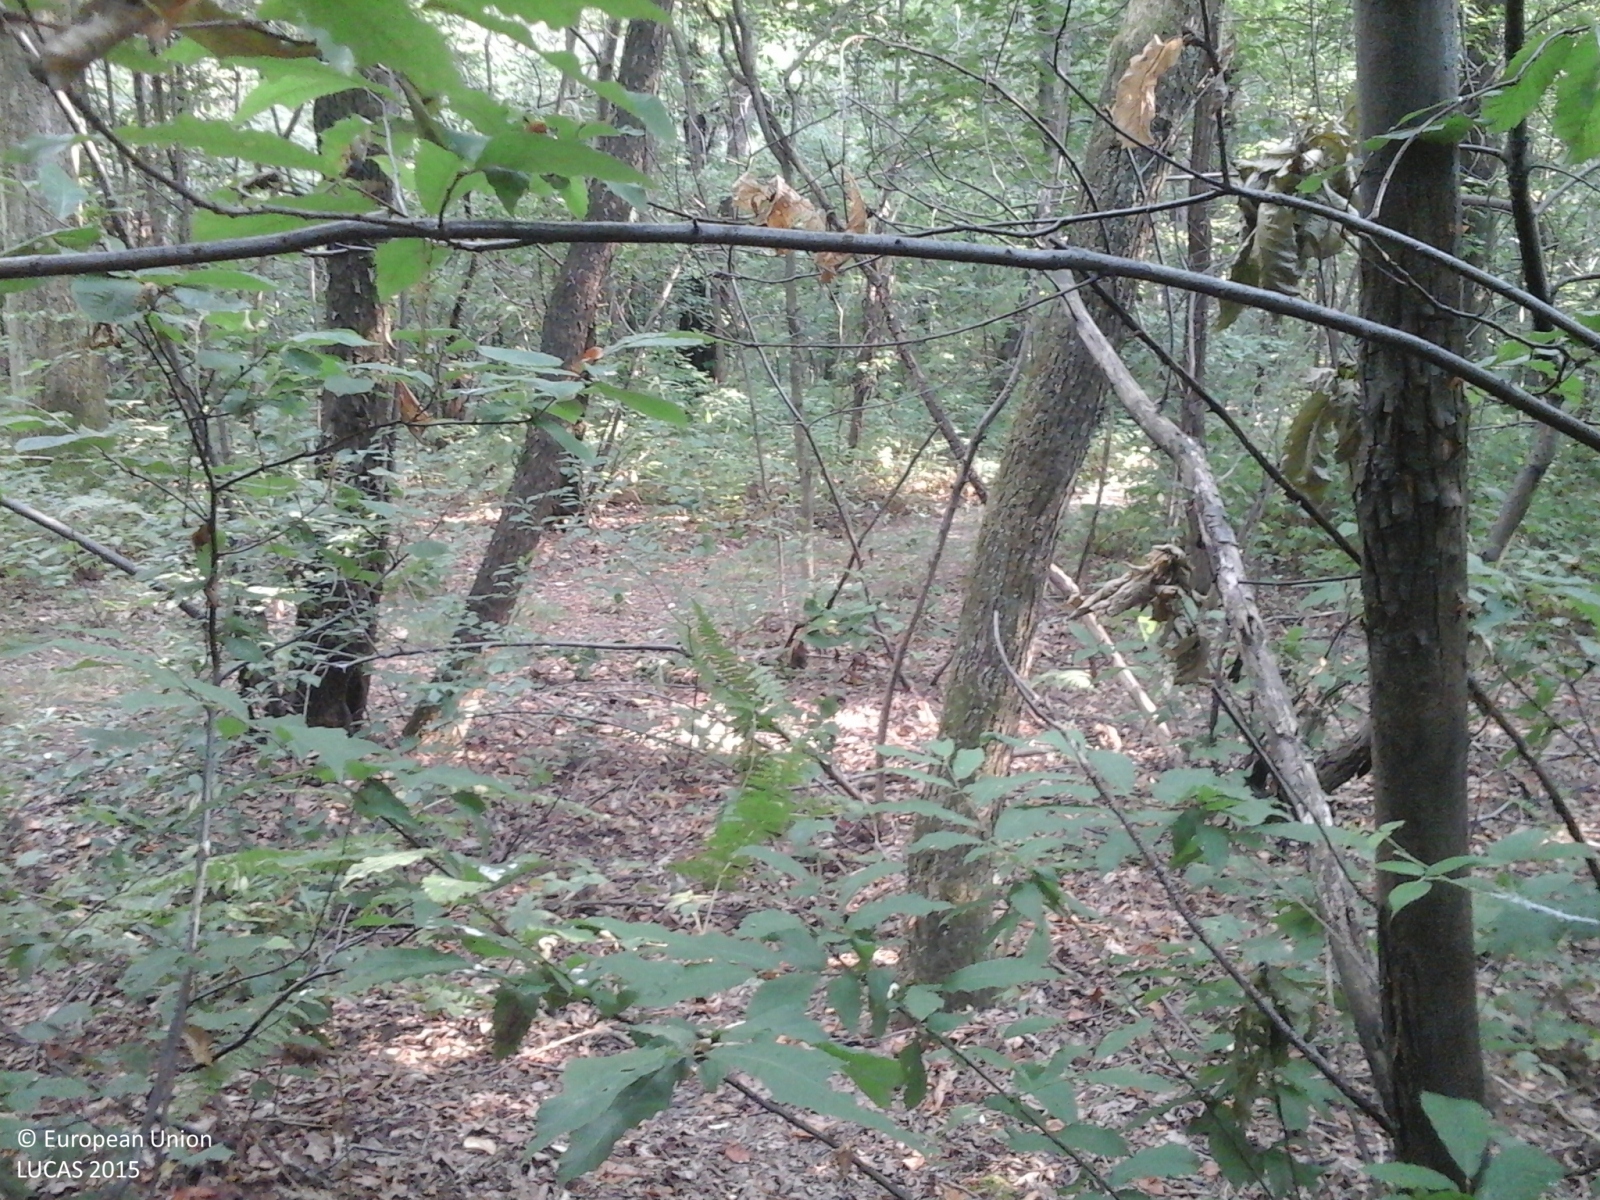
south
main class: Woodland
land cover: Broadleaved woodland
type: thermophilous deciduous forest
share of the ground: > 75 %
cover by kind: broadleaved forest trees 75 %, coniferous forest trees 25 %
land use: Forestry
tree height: > 5 m
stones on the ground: < 10 %
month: July
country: IT
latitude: 45.7136
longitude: 8.7815
